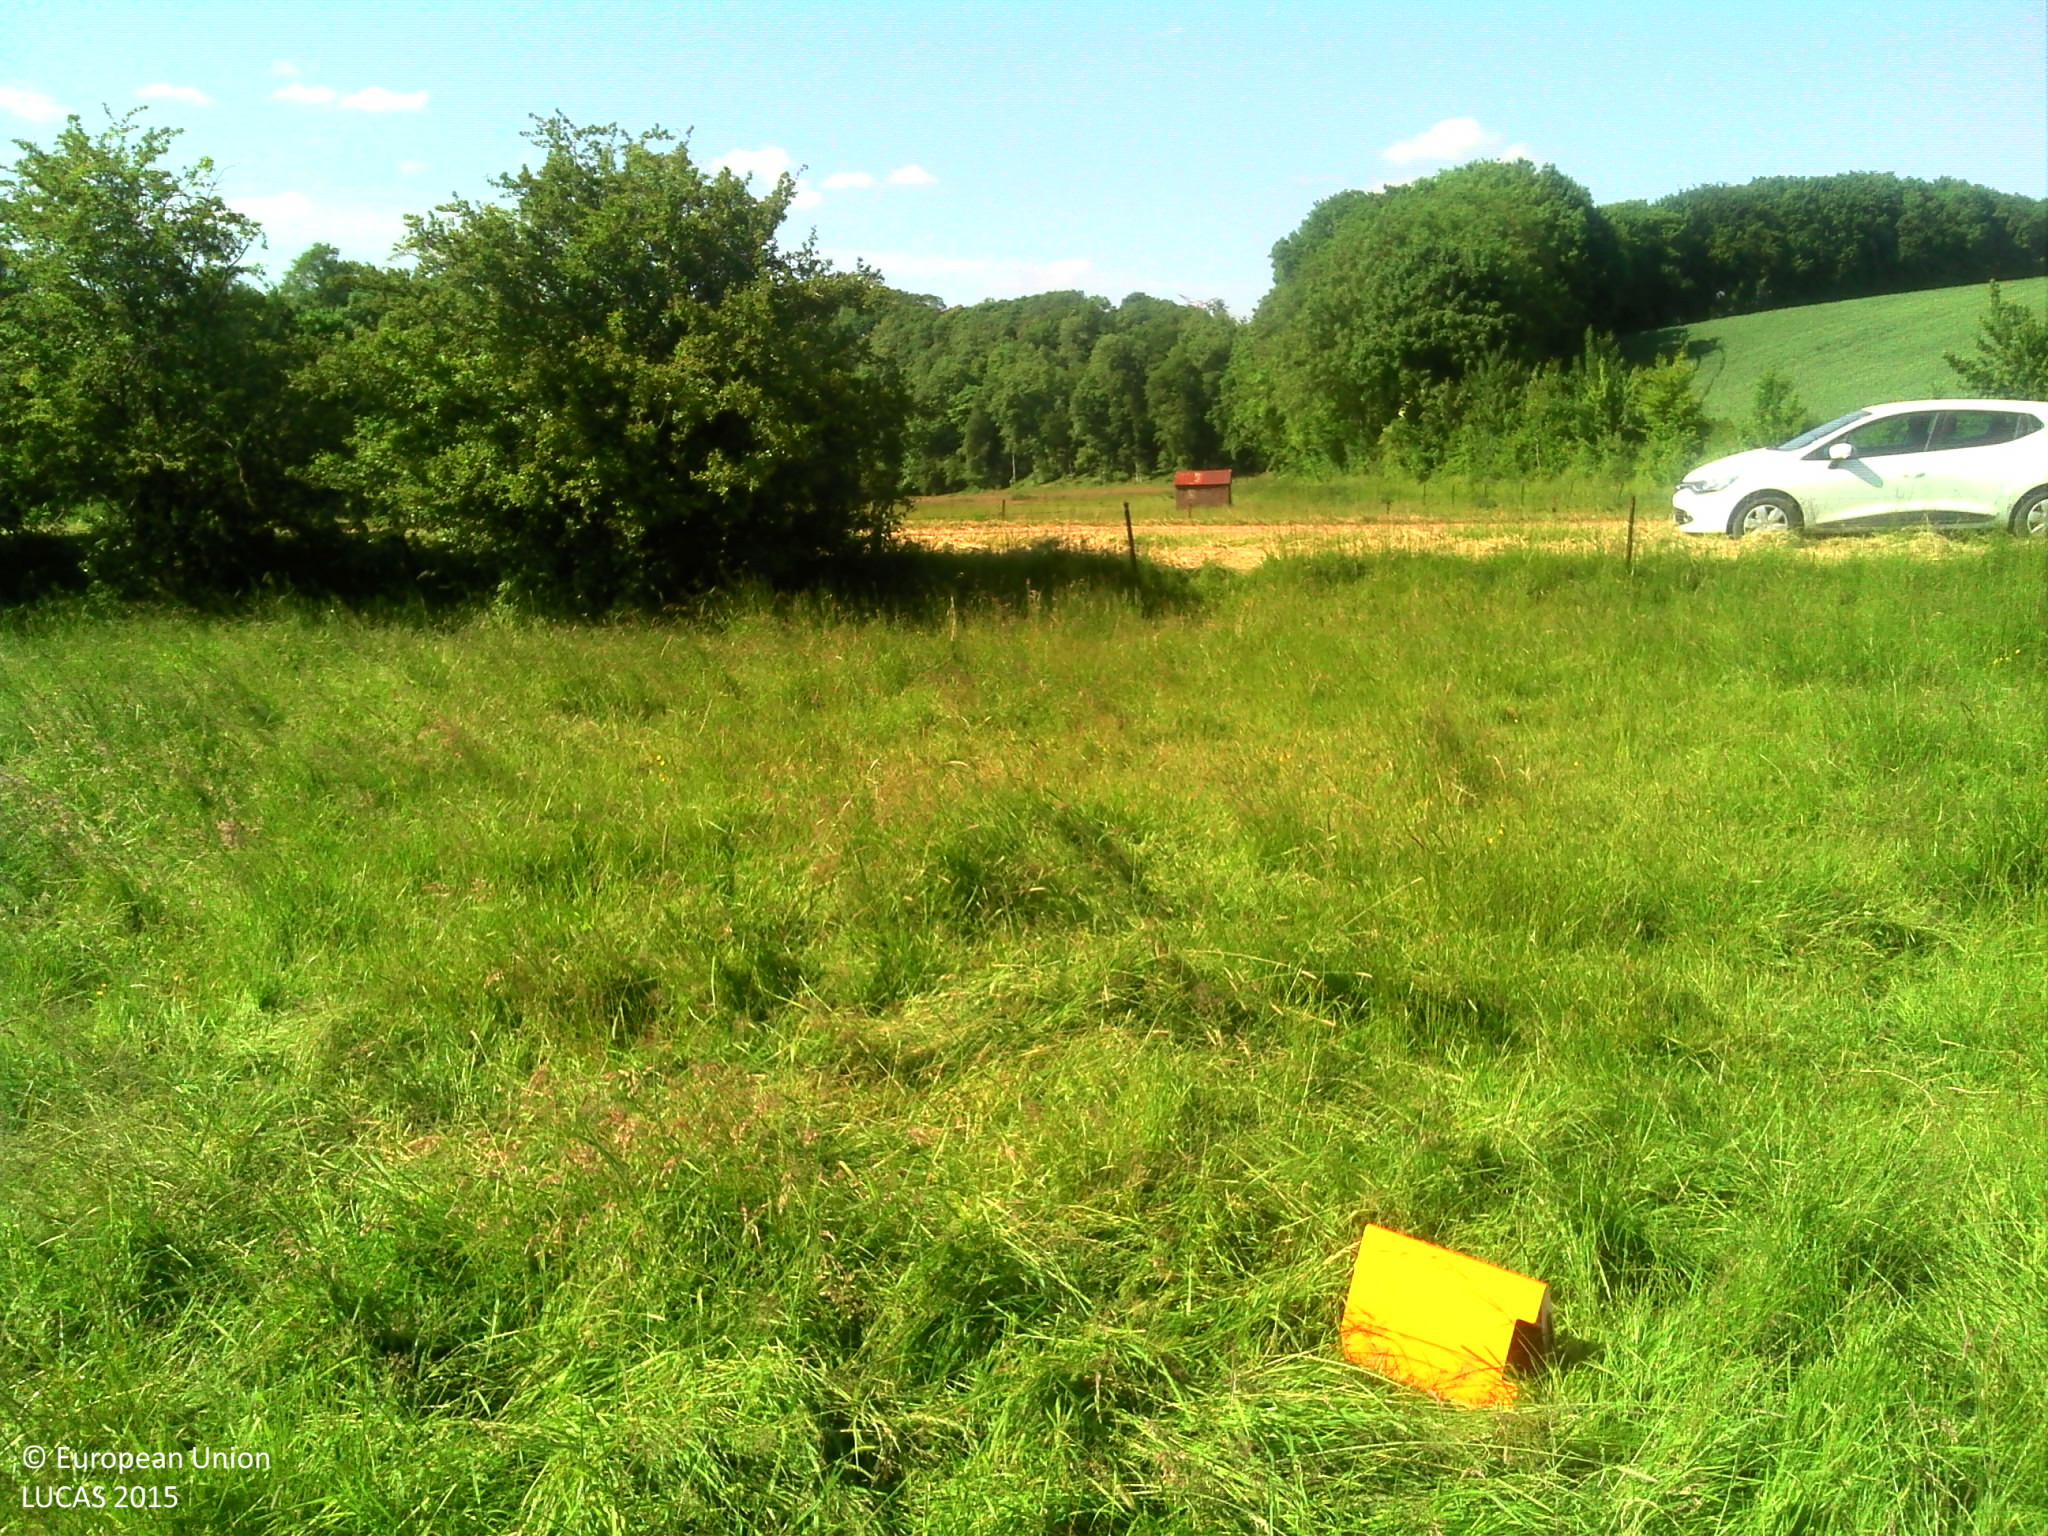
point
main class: Grassland
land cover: Grassland without tree/shrub cover
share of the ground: > 75 %
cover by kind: herbaceous plants 100 %
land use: Agriculture (excluding fallow land and kitchen gardens)
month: June
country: FR
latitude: 49.8697
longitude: 4.1095
